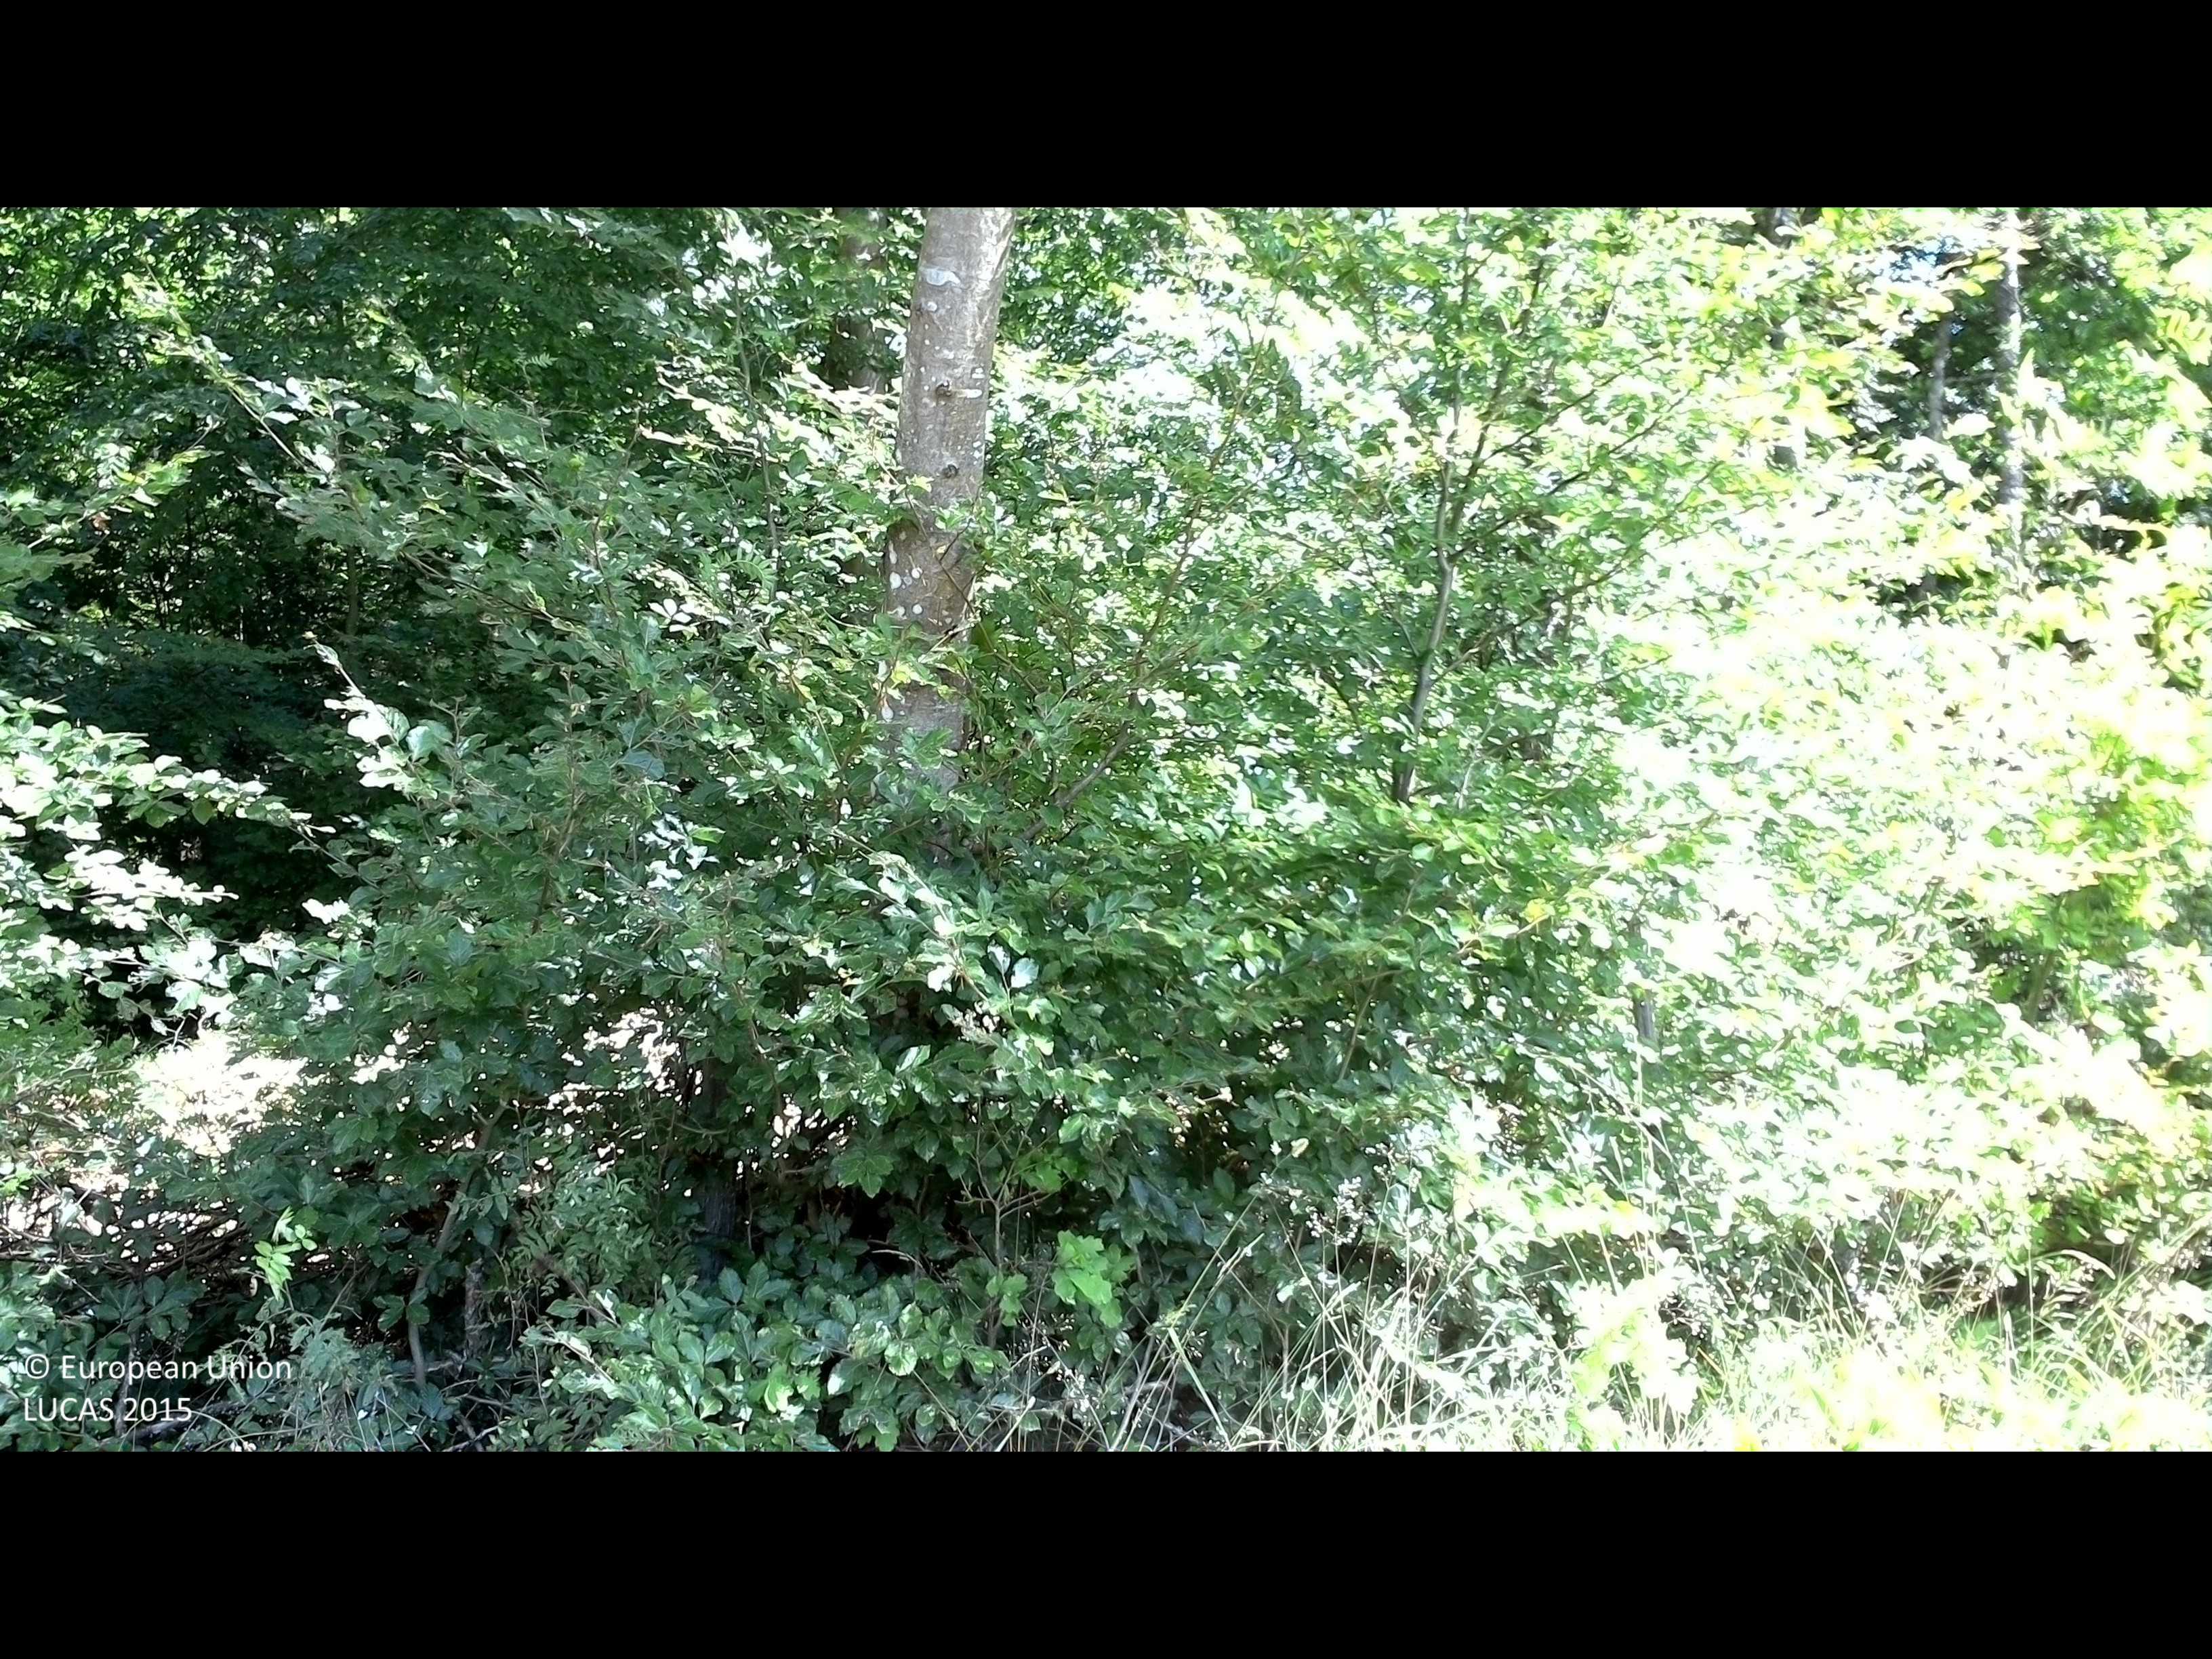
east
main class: Woodland
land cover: Broadleaved woodland
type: beech forest
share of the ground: > 75 %
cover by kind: broadleaved forest trees 75 %, herbaceous plants 20 %, shrubs 5 %
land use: Forestry
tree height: > 5 m
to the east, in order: Paved roads, cycling and walking lanes; Broadleaved woodland; Fences; Broadleaved woodland; Fences; Dry stone walls; Groves; Grassland without tree/shrub cover; Abandoned hedges; Dry stone walls; Grassland without tree/shrub cover; Grass margins; Abandoned hedges; Dry stone walls; Groves; Spruce dominated coniferous woodland; Broadleaved woodland
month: July
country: SE
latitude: 56.3709
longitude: 15.1958
